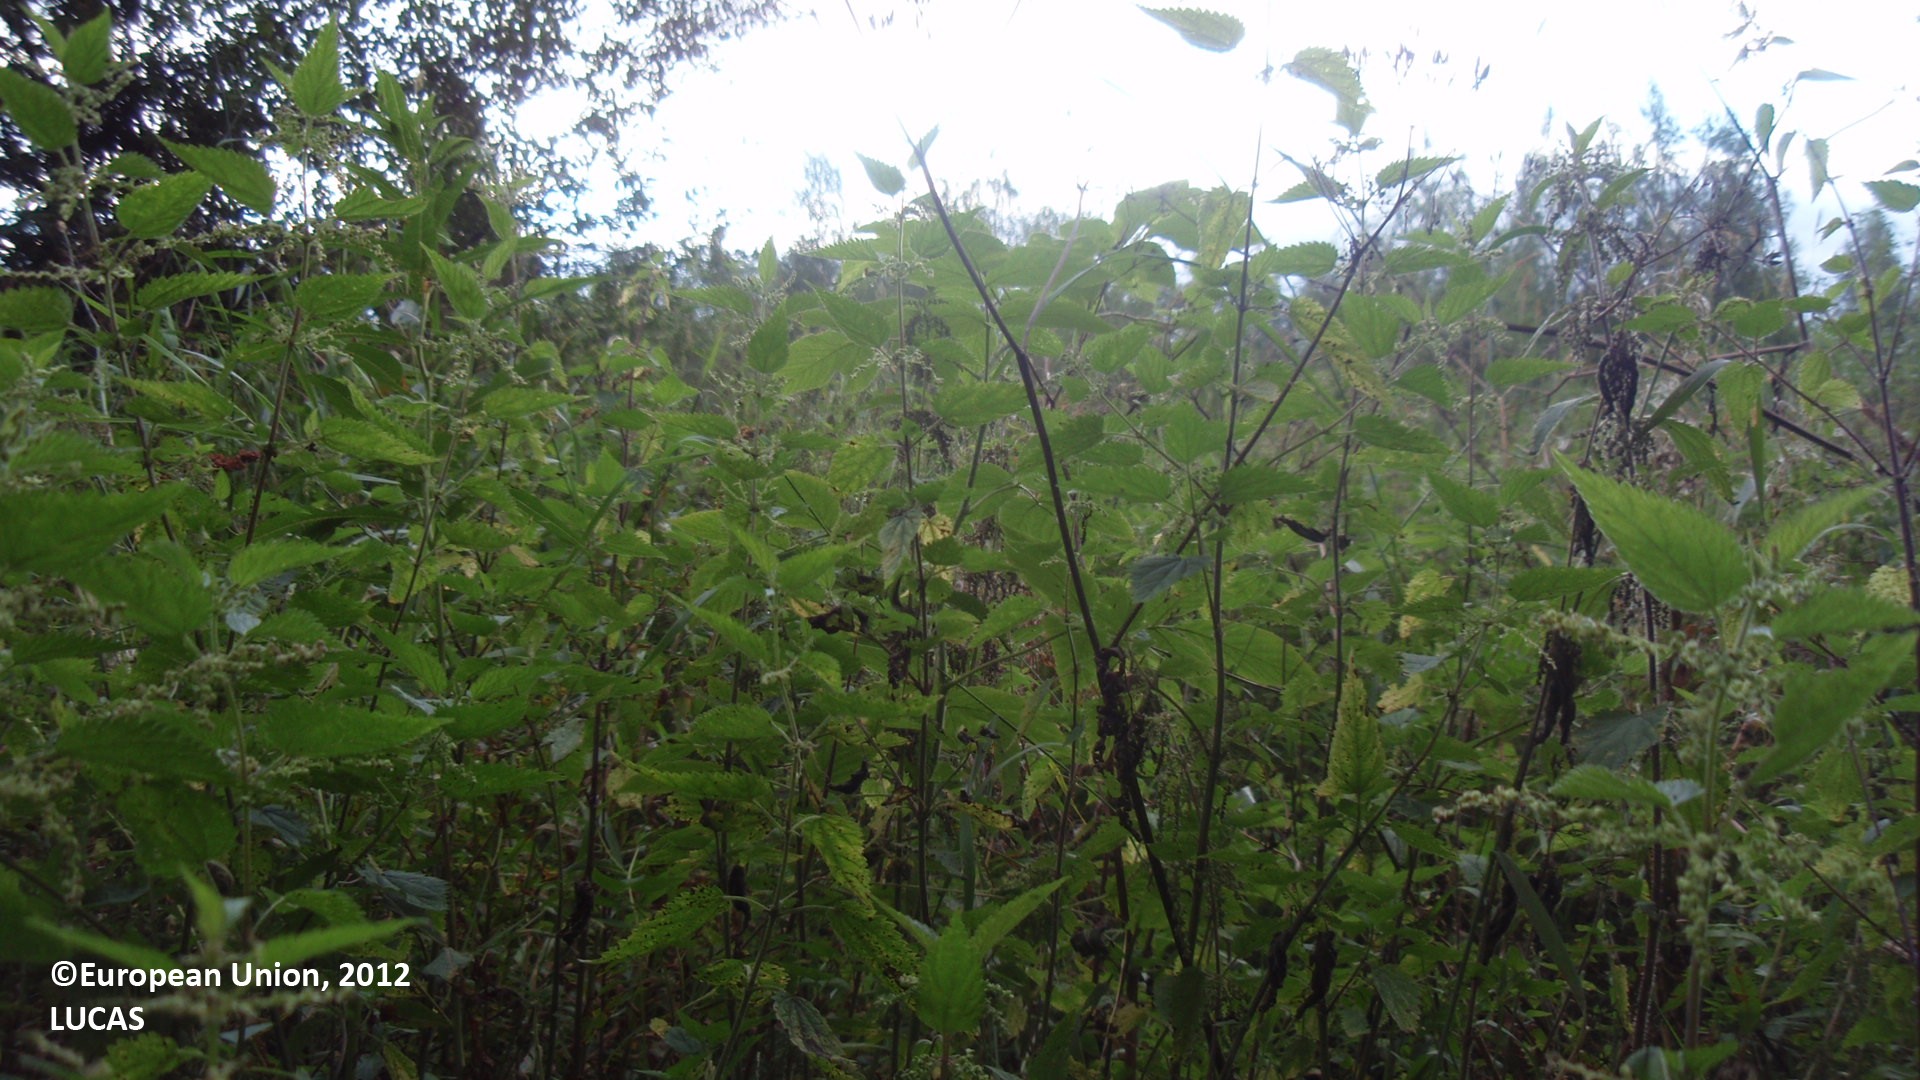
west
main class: Shrubland
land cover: Shrubland with sparse tree cover
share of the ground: > 75 %
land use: Abandoned areas
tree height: < 5 m
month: August
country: FI
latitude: 61.1717
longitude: 27.6041
